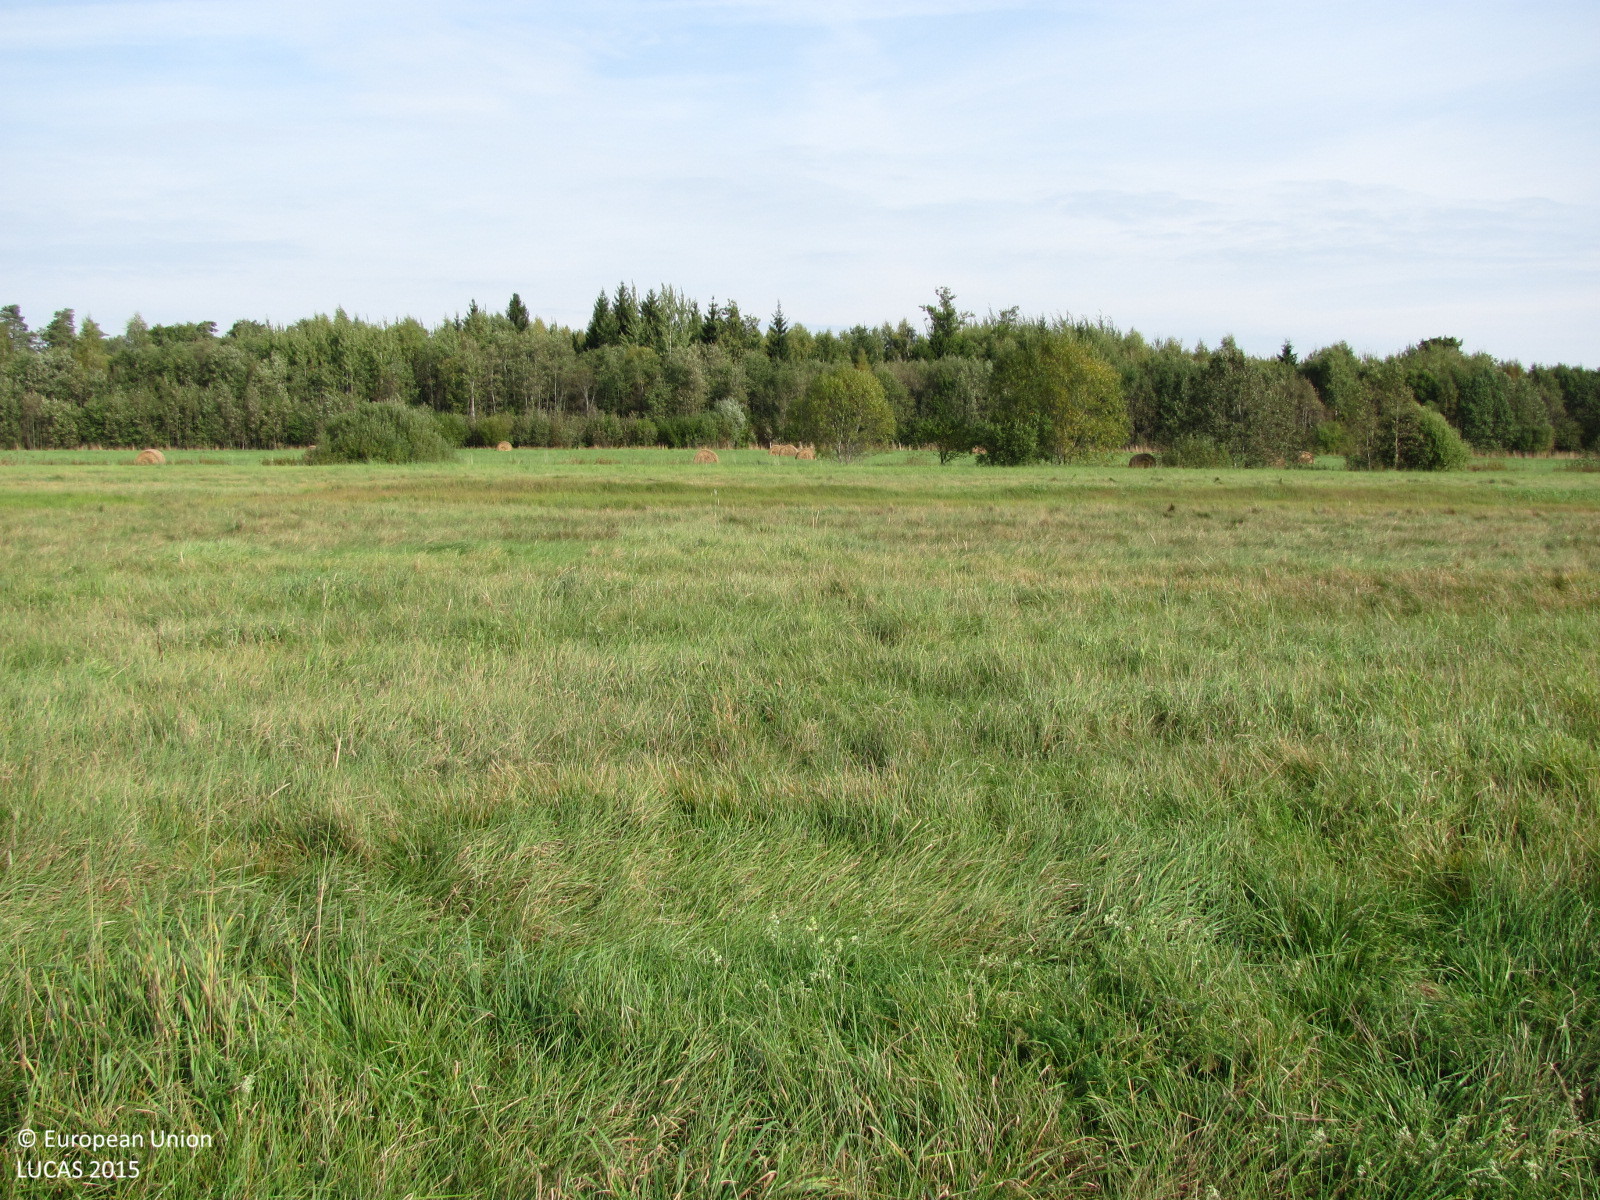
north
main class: Grassland
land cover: Grassland without tree/shrub cover
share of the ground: > 75 %
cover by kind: herbaceous plants 100 %
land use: Agriculture (excluding fallow land and kitchen gardens)
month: September
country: LV
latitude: 57.2228
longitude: 24.6877
